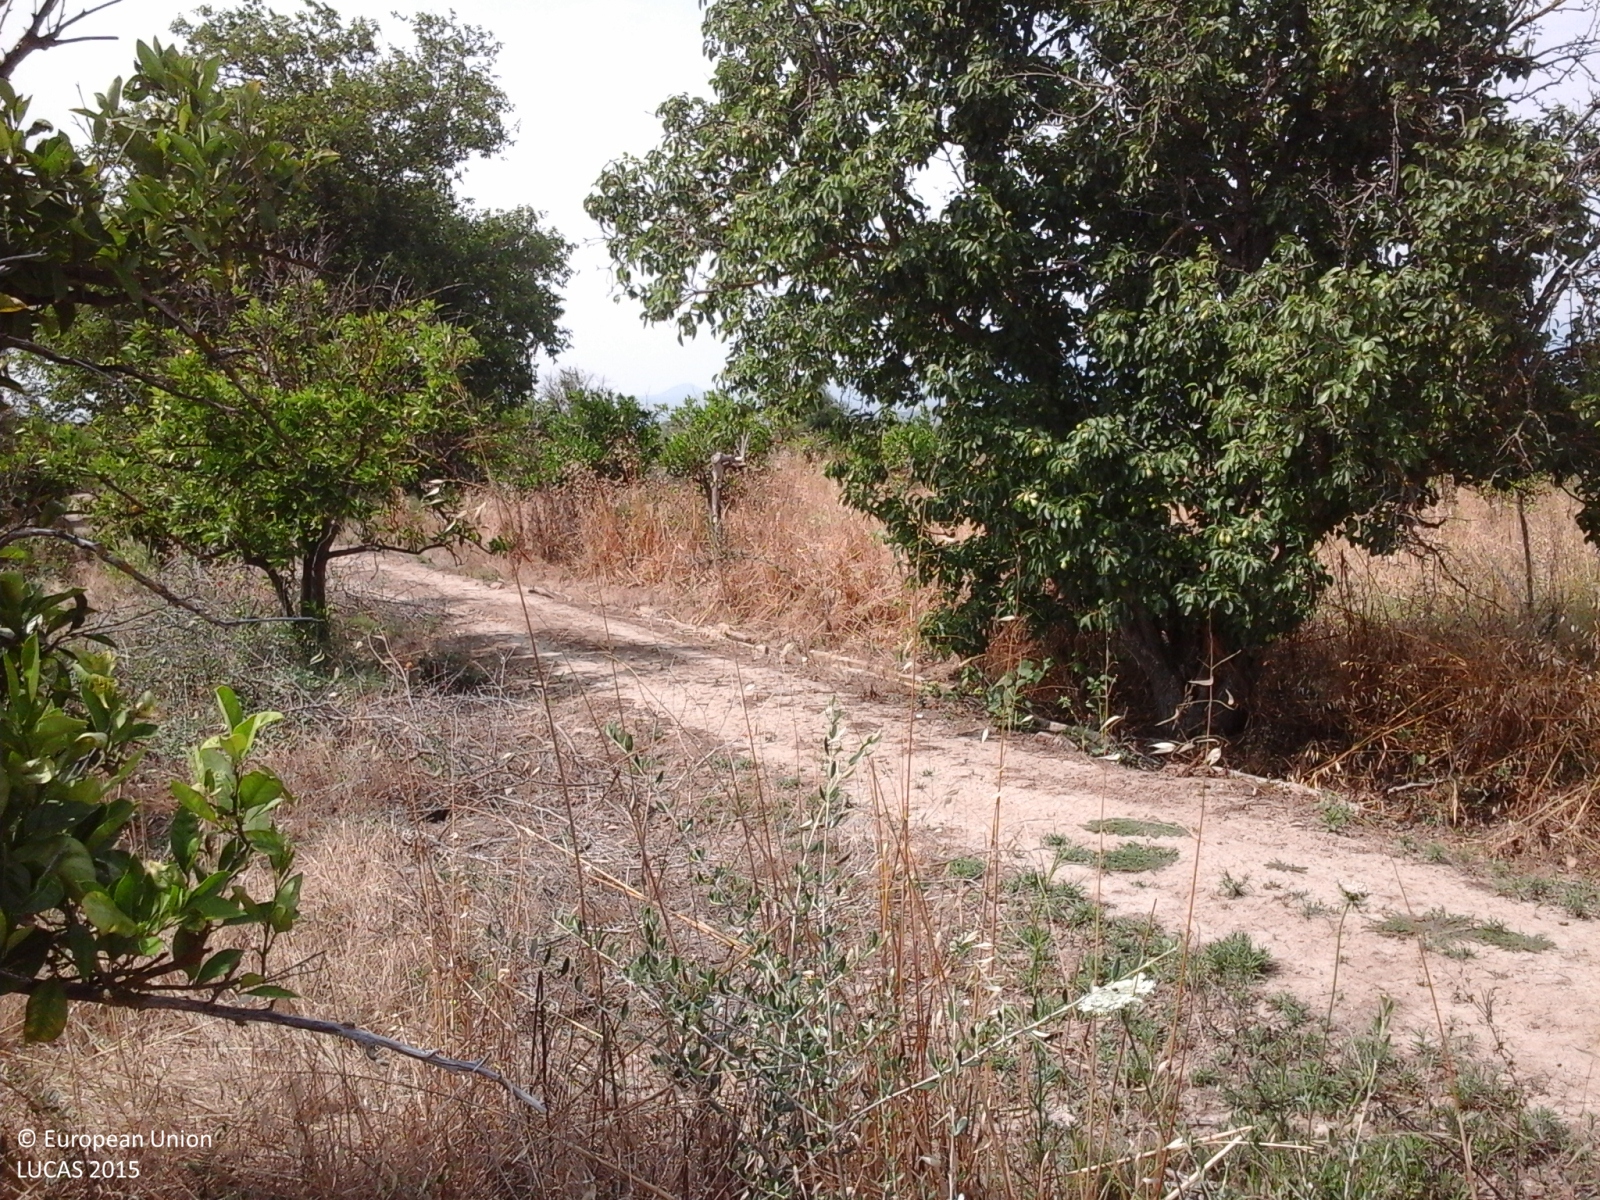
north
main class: Cropland
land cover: Oranges
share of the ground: 50 - 75 %
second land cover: Spontaneously vegetated surfaces
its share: > 75 %
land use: Abandoned areas
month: June
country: IT
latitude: 37.4947
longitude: 14.8848
